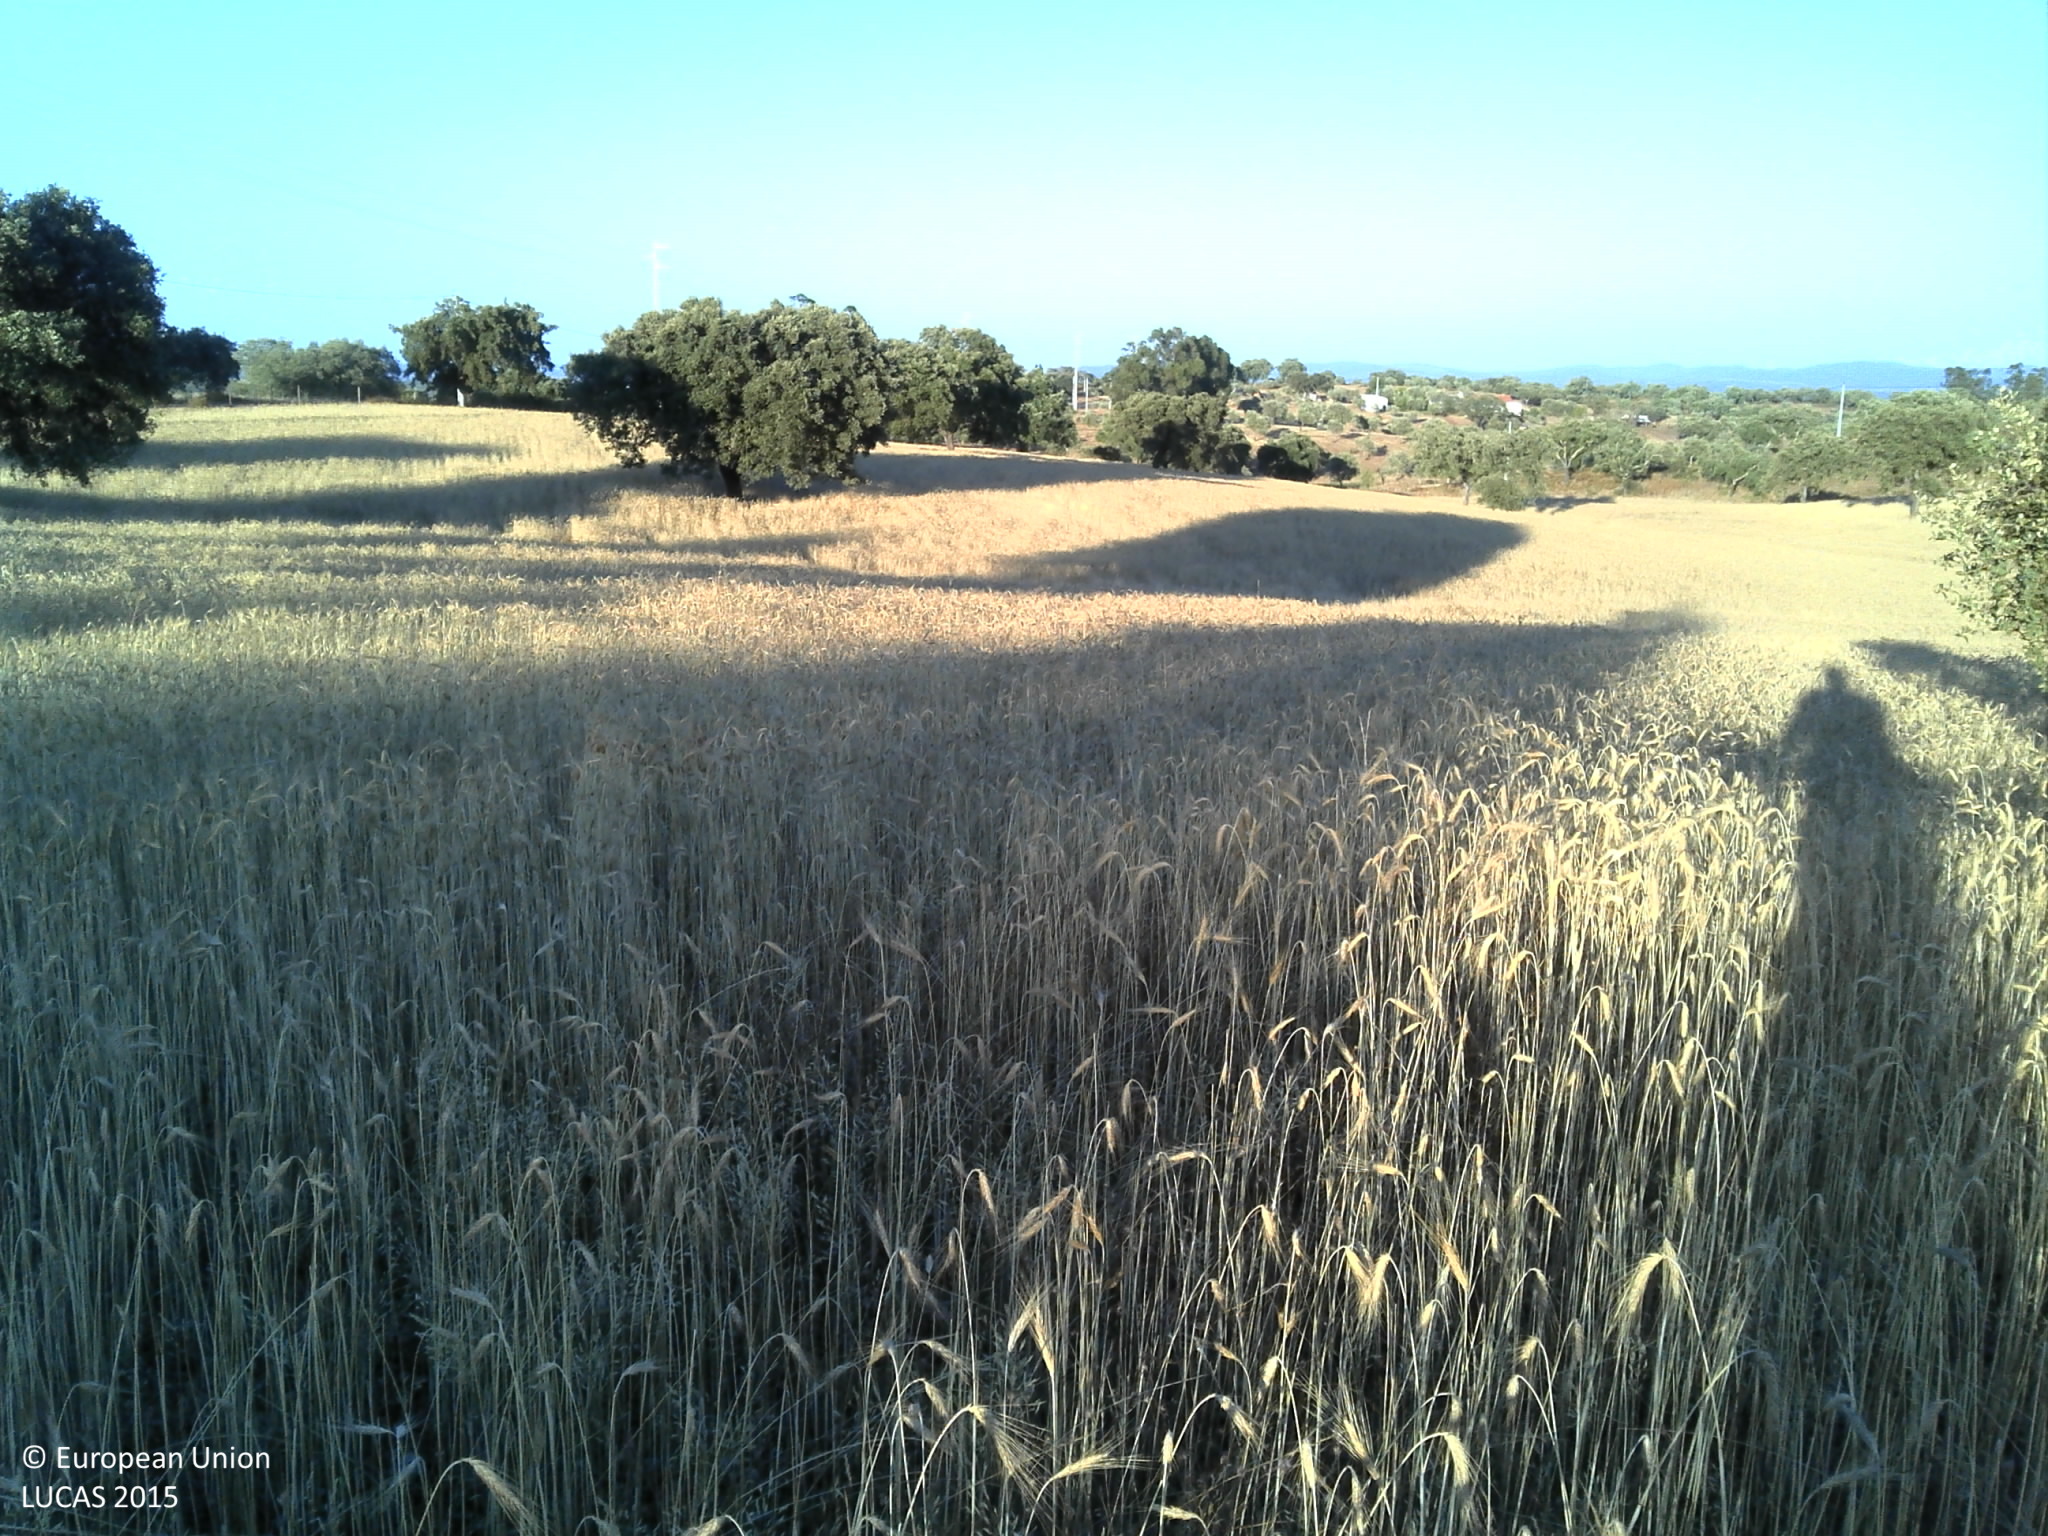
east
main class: Cropland
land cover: Common wheat
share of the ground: > 75 %
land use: Agriculture (excluding fallow land and kitchen gardens)
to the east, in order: Common wheat; Single bushes/trees; Common wheat; Single bushes/trees; Common wheat; Single bushes/trees; Common wheat; Grass margins; Fences; Grass margins; Tracks; Fences; Electric lines; Grassland without tree/shrub cover; Fences; Tracks; Grass margins; Fences; Grass margins; Other structural elements
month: June
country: PT
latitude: 37.8986
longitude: -7.3335
